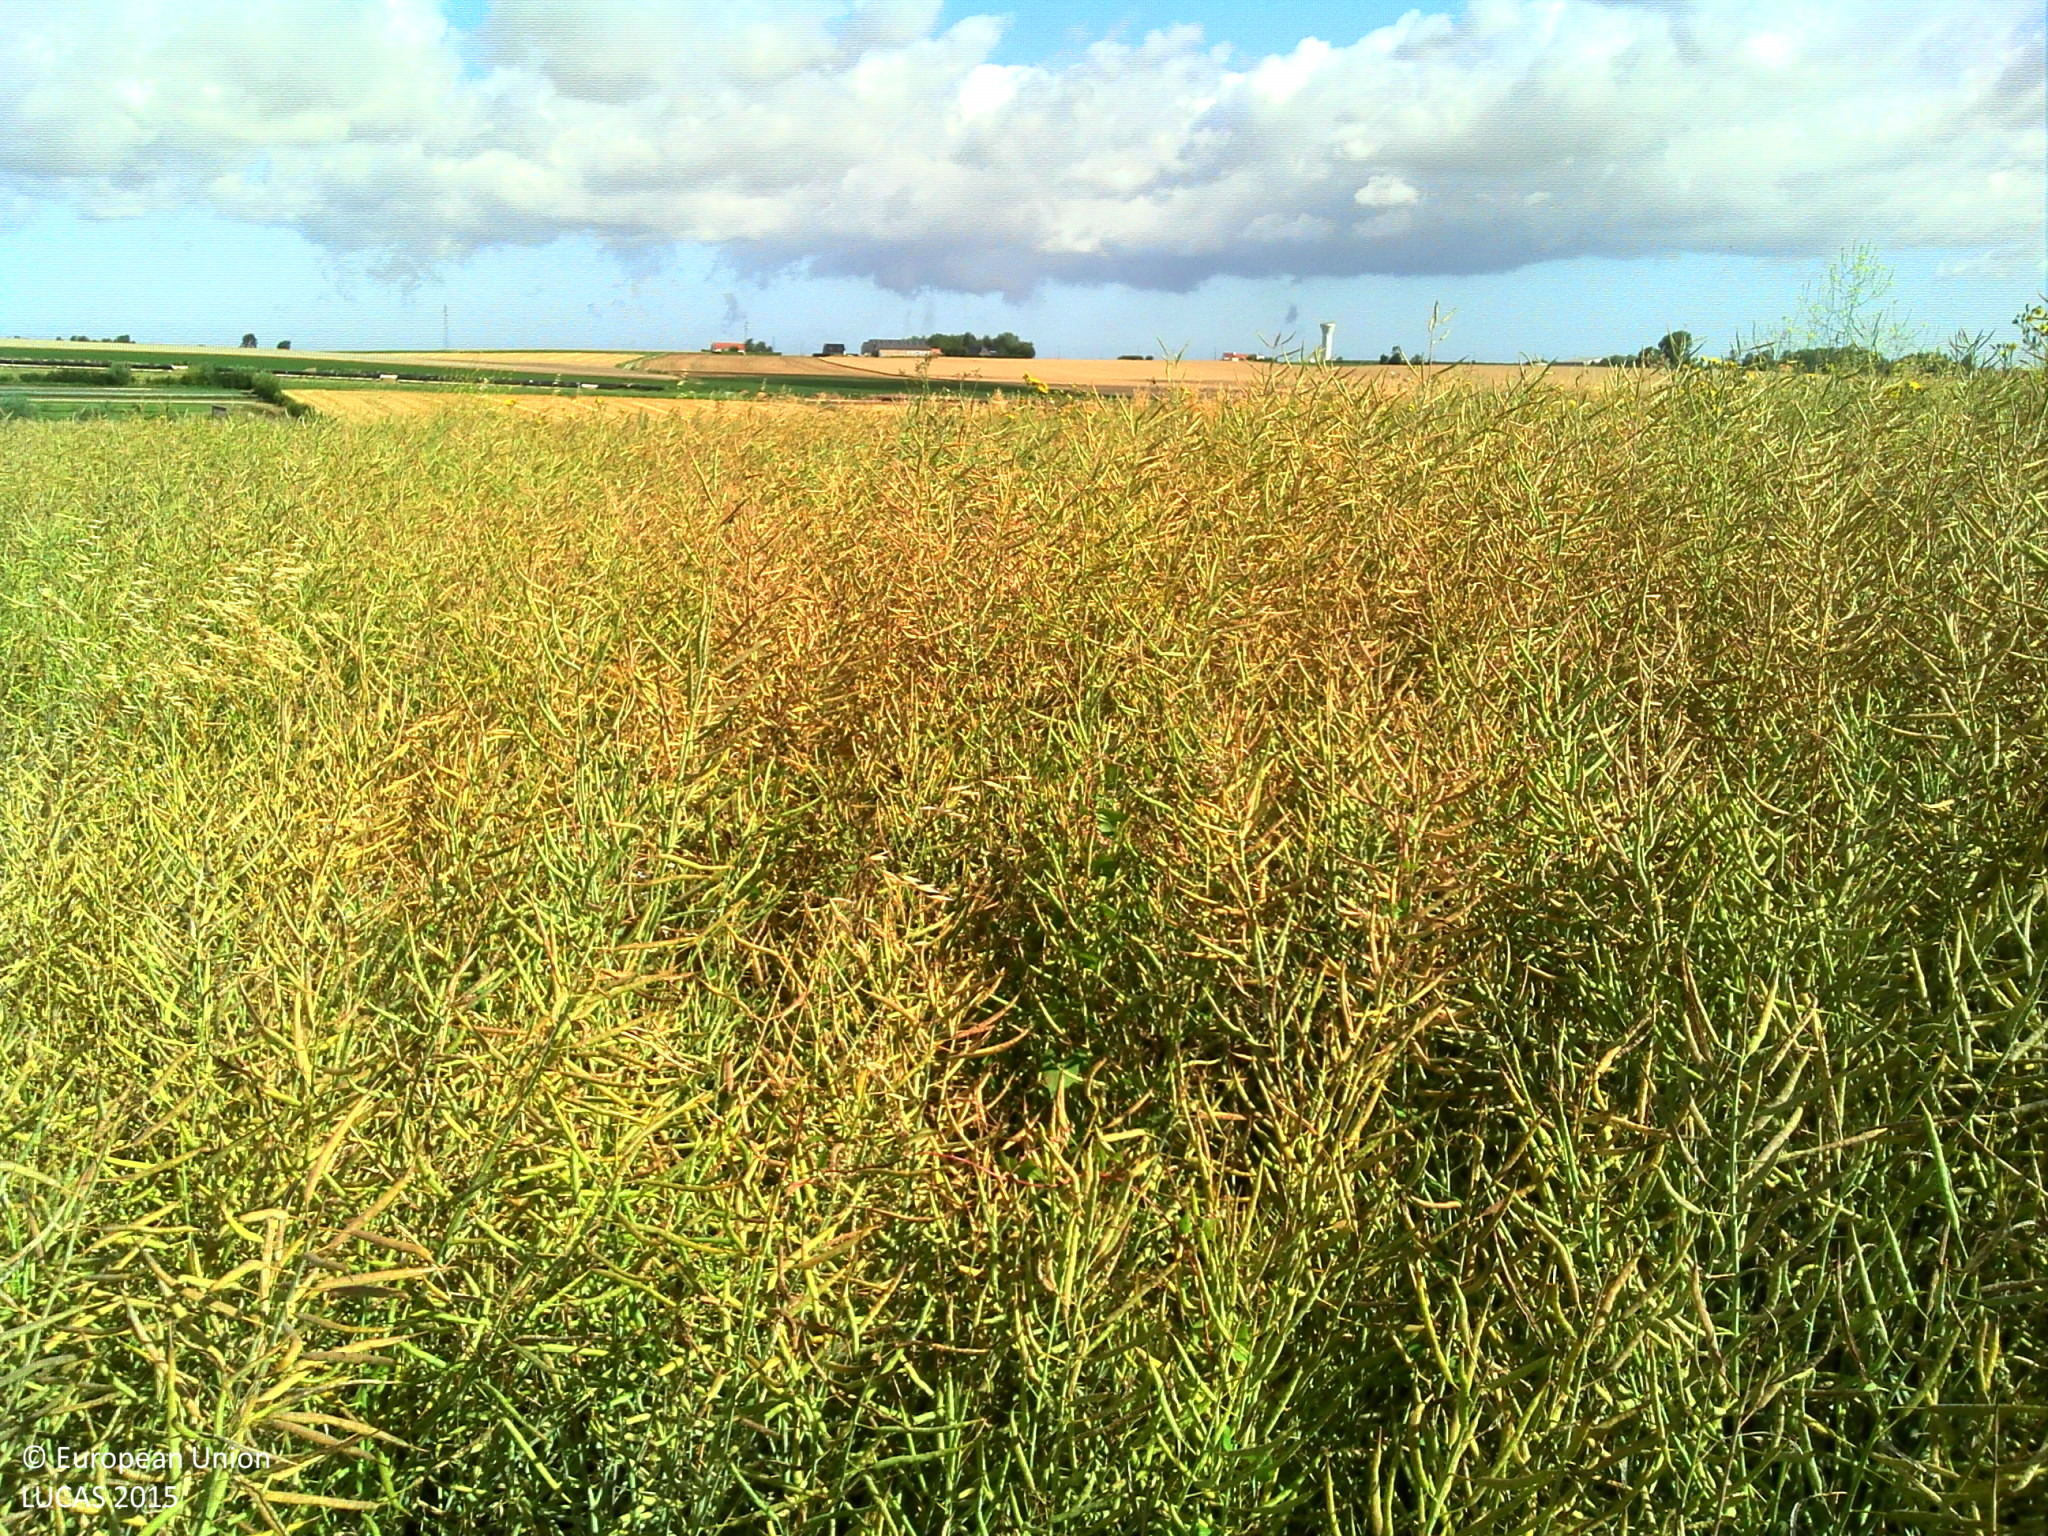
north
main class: Cropland
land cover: Rape and turnip rape
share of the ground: > 75 %
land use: Agriculture (excluding fallow land and kitchen gardens)
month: July
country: FR
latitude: 50.9203
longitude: 2.3473
